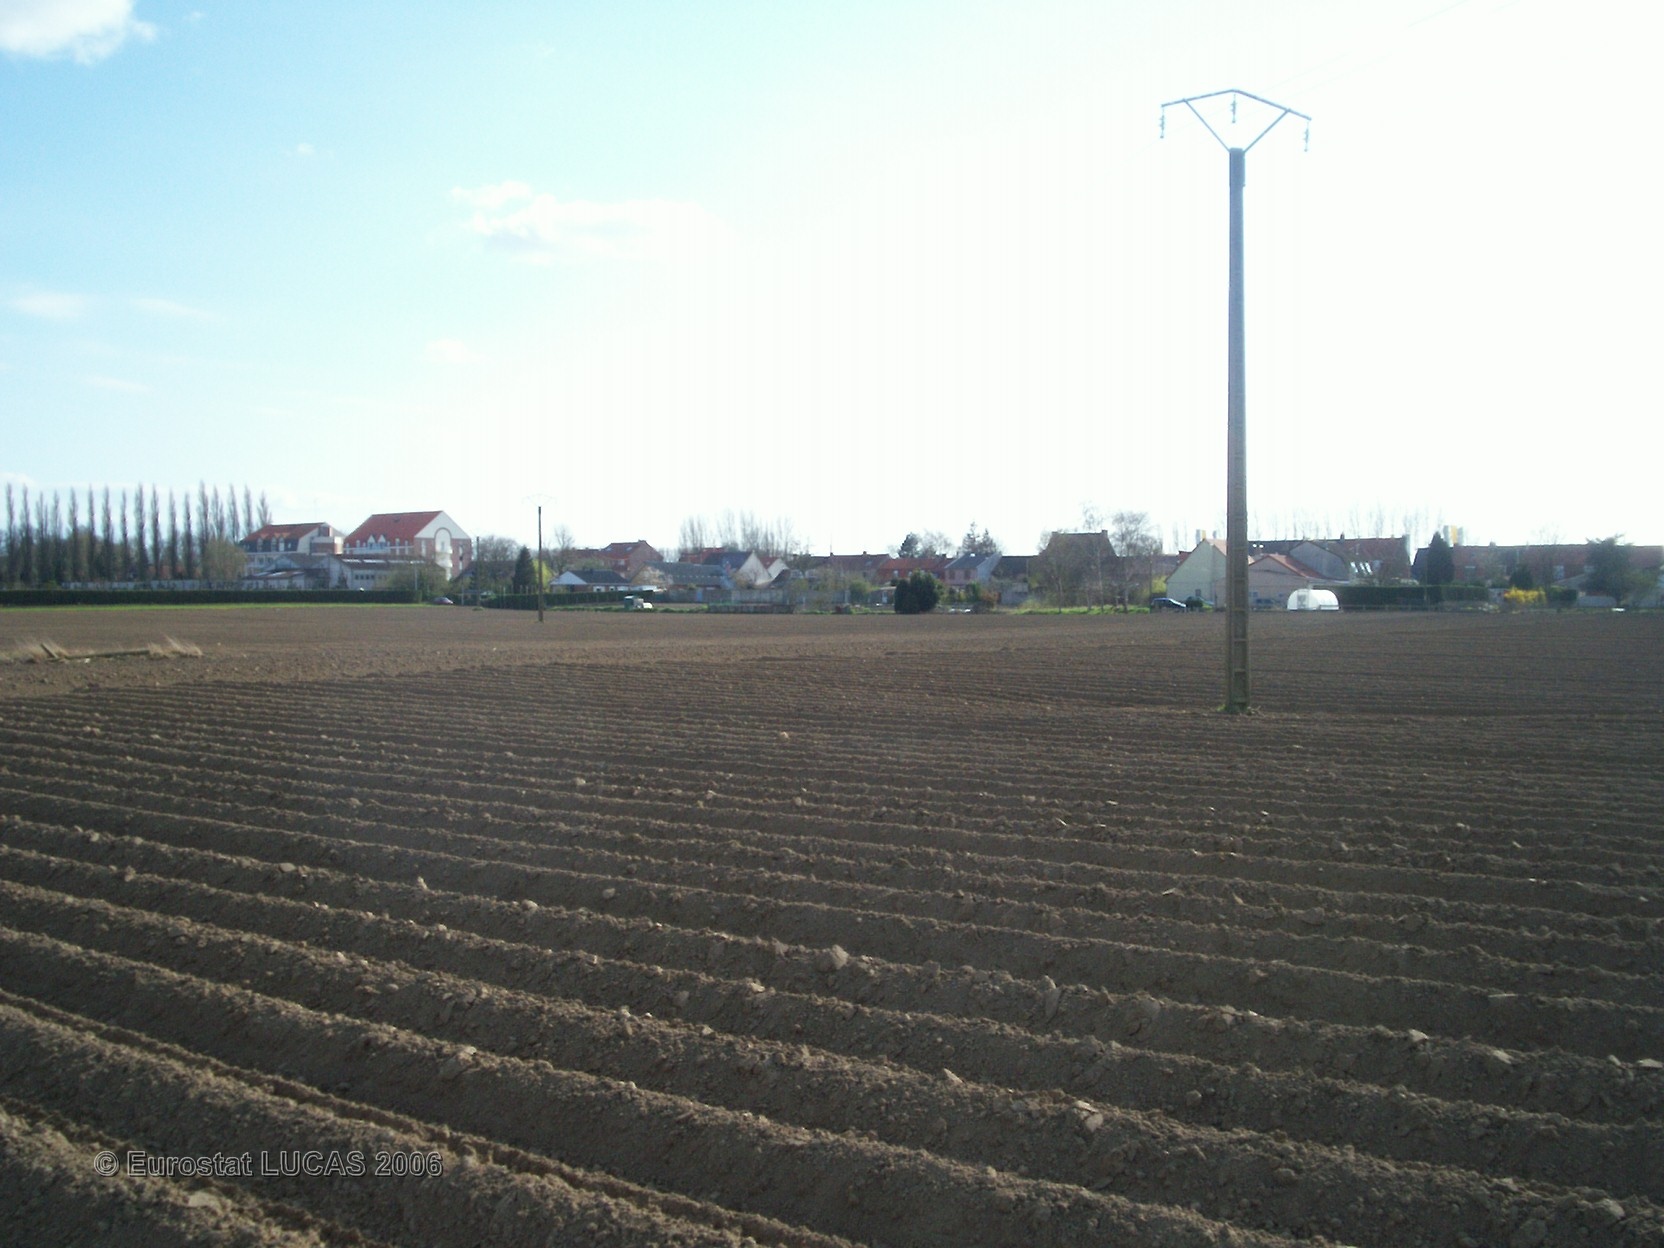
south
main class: Cropland
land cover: Potatoes
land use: Agriculture (excluding fallow land and kitchen gardens)
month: May
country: FR
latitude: 50.8920
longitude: 2.4664
